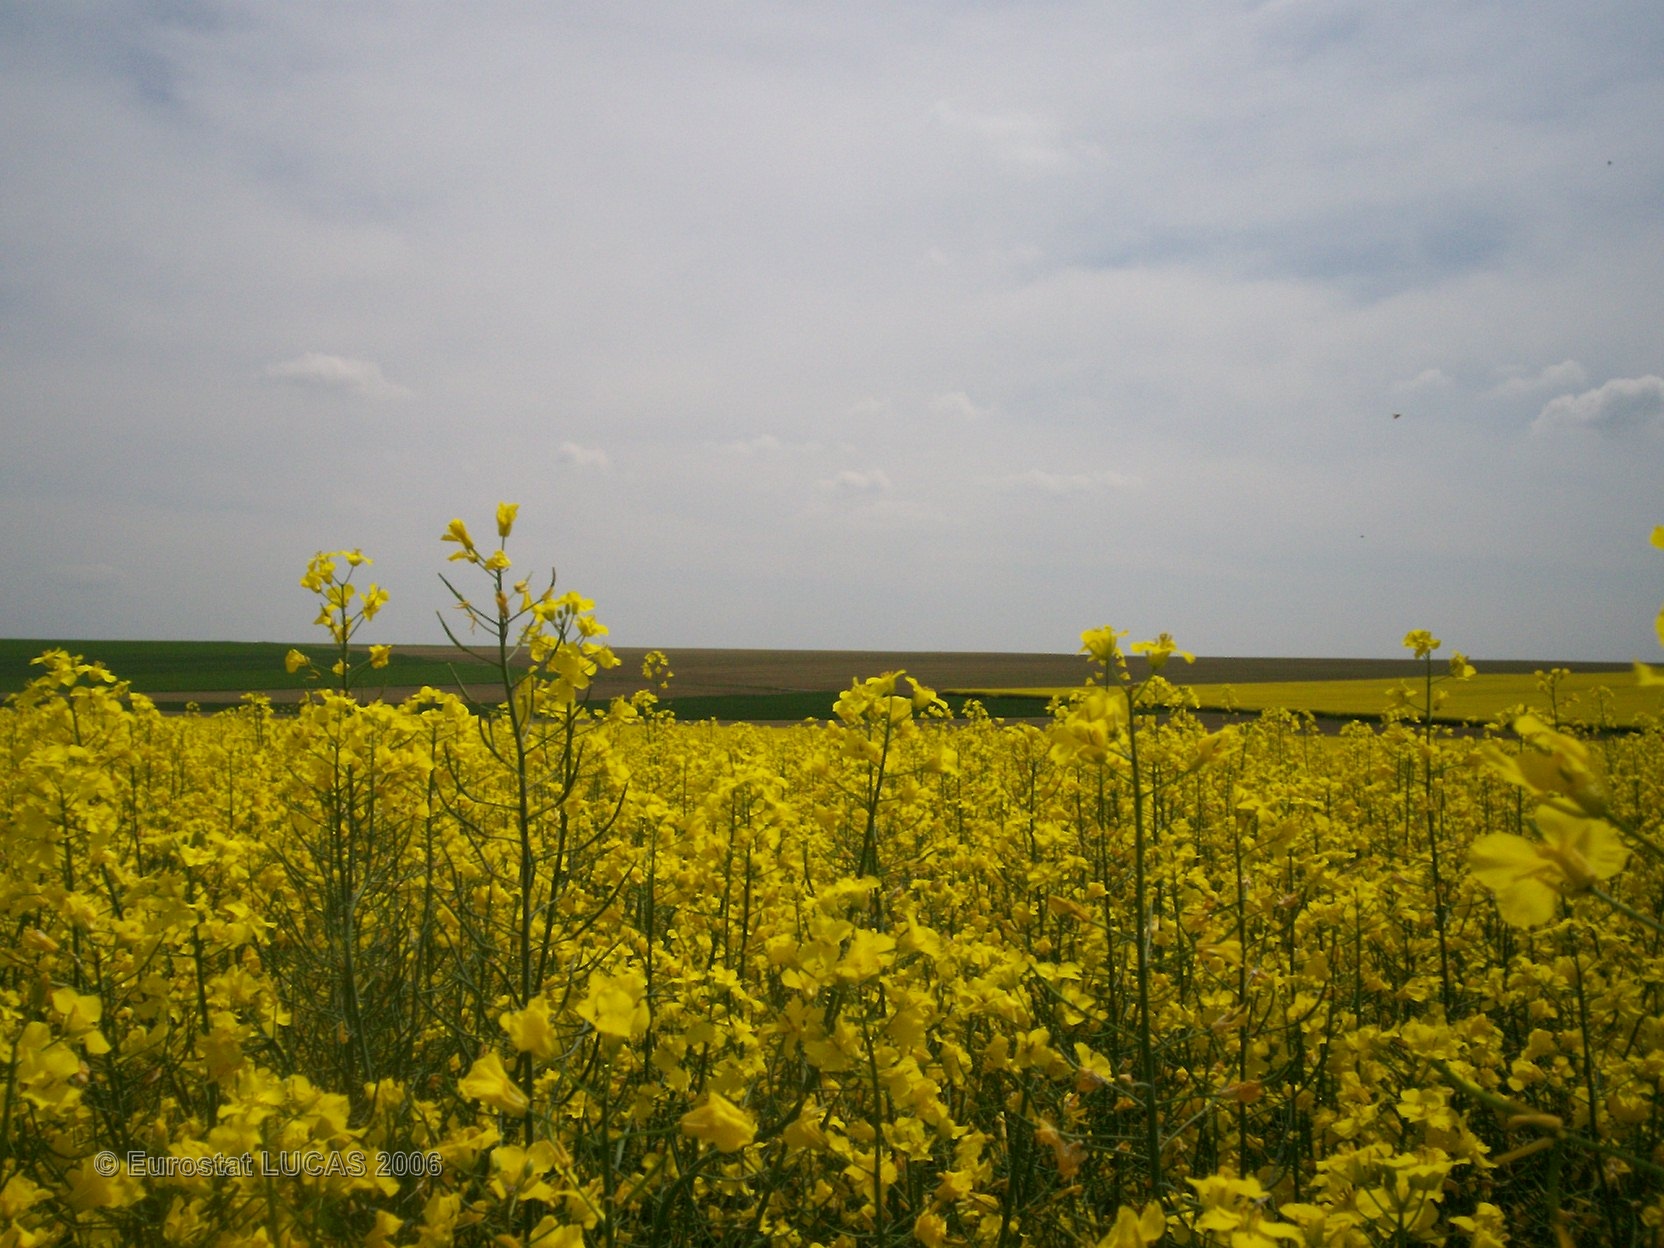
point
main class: Cropland
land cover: Rape and turnip rape
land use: Agriculture (excluding fallow land and kitchen gardens)
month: May
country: FR
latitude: 48.9309
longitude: 4.4410
